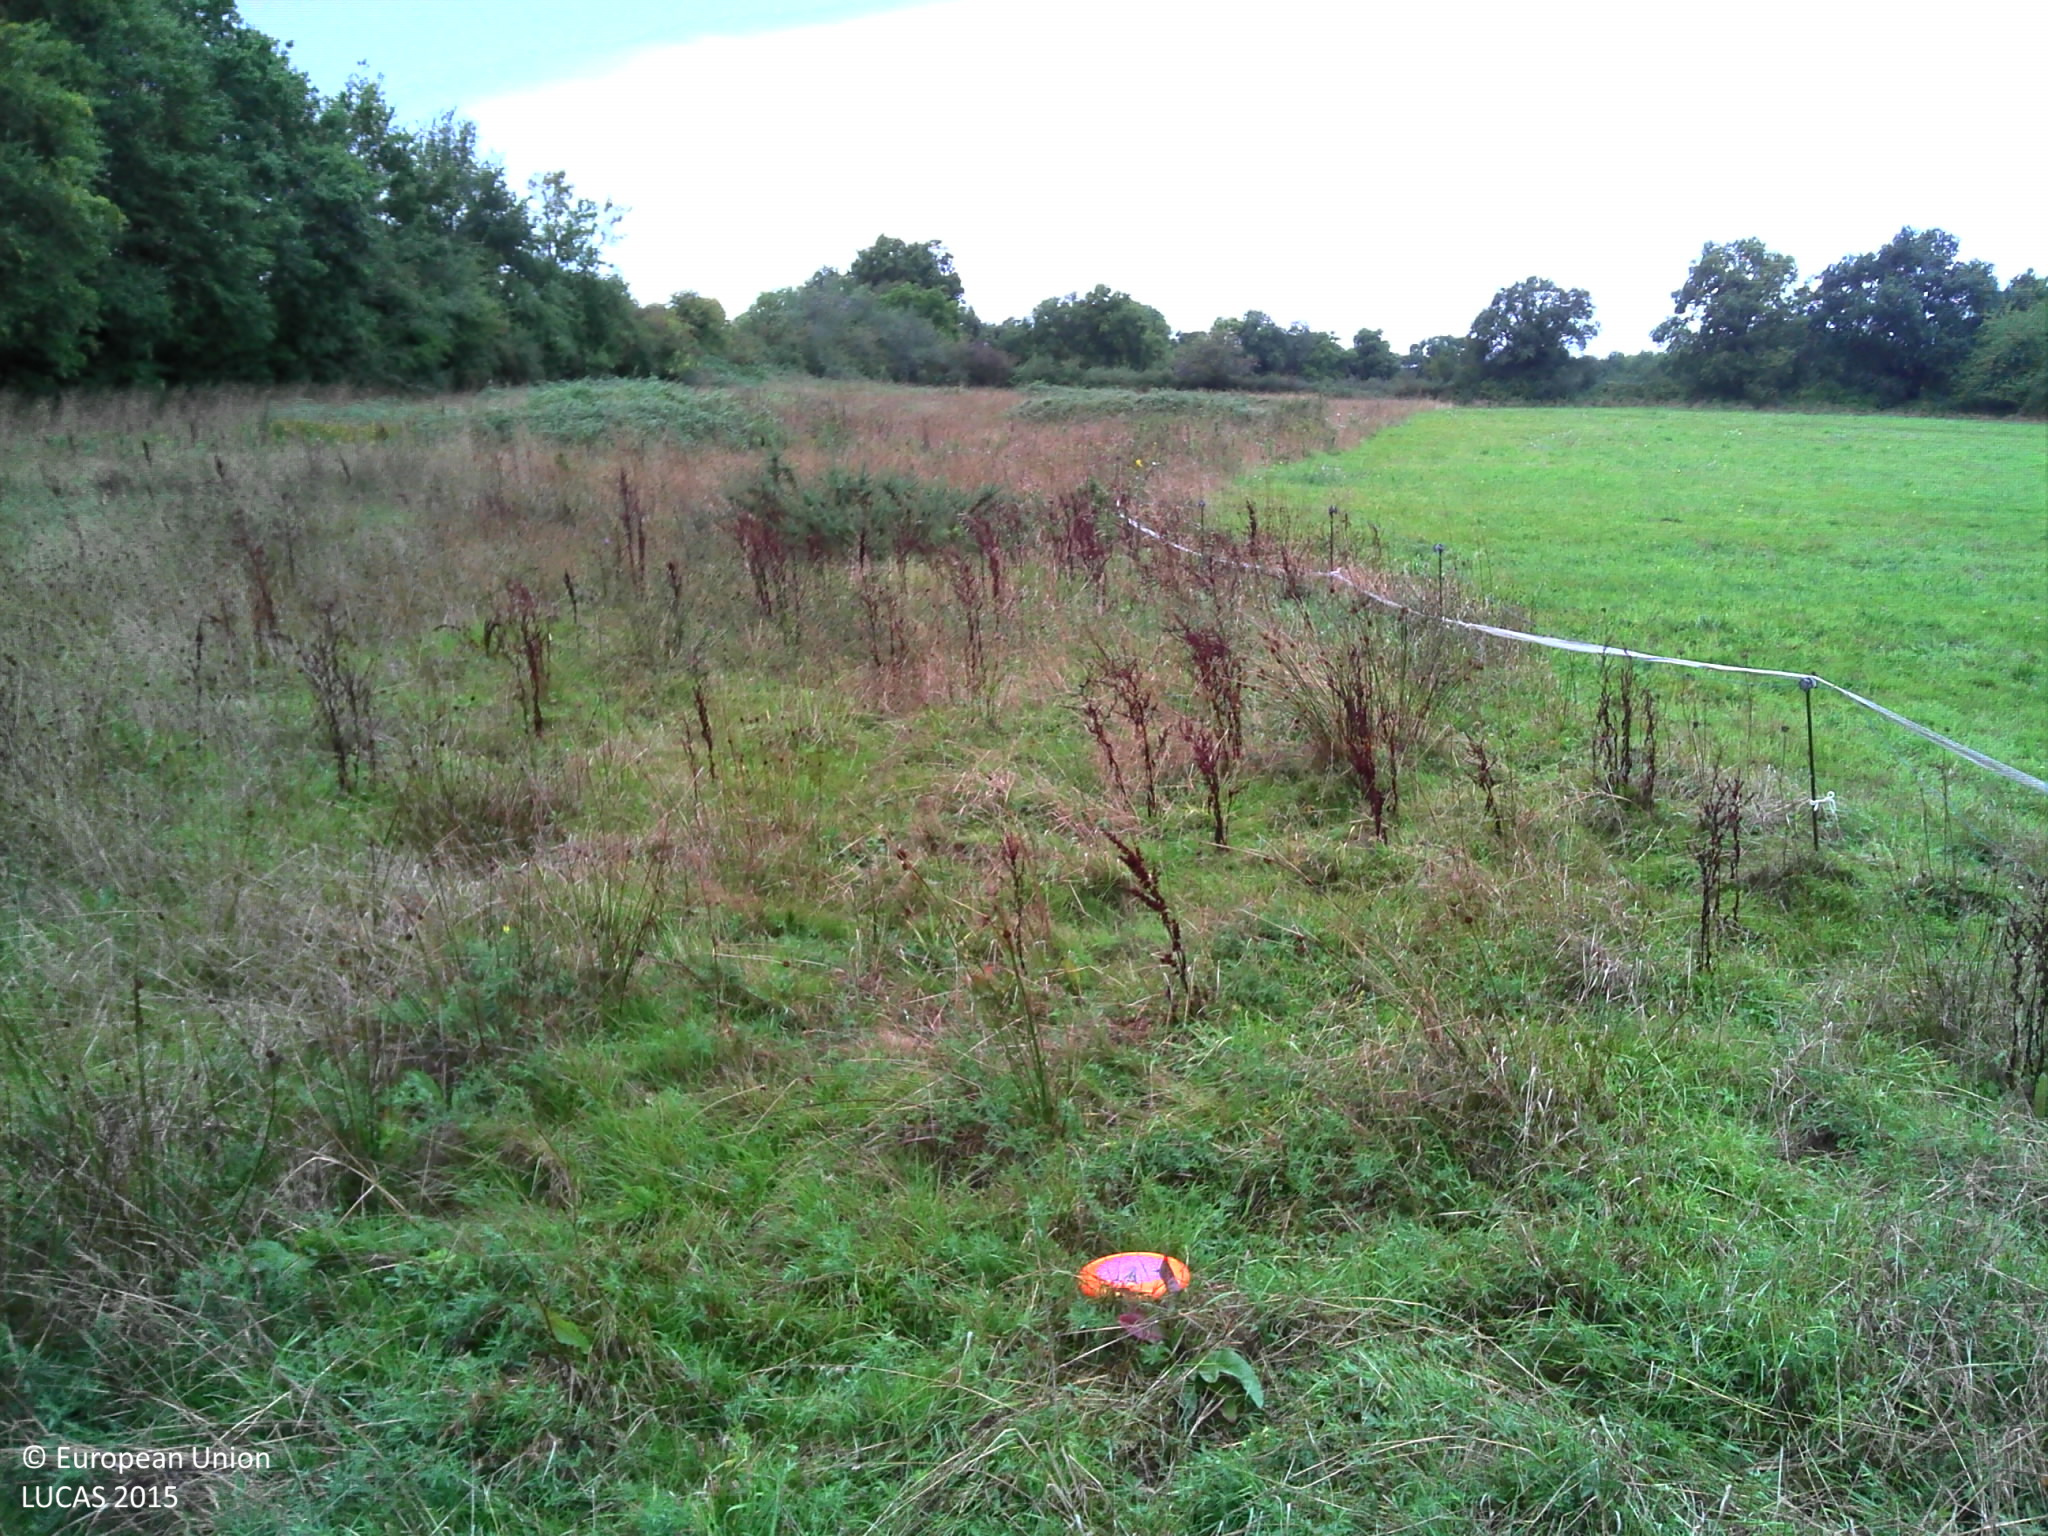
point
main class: Grassland
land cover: Grassland without tree/shrub cover
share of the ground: > 75 %
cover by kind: herbaceous plants 100 %
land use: Agriculture (excluding fallow land and kitchen gardens)
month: September
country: FR
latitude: 46.6412
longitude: 1.6684
